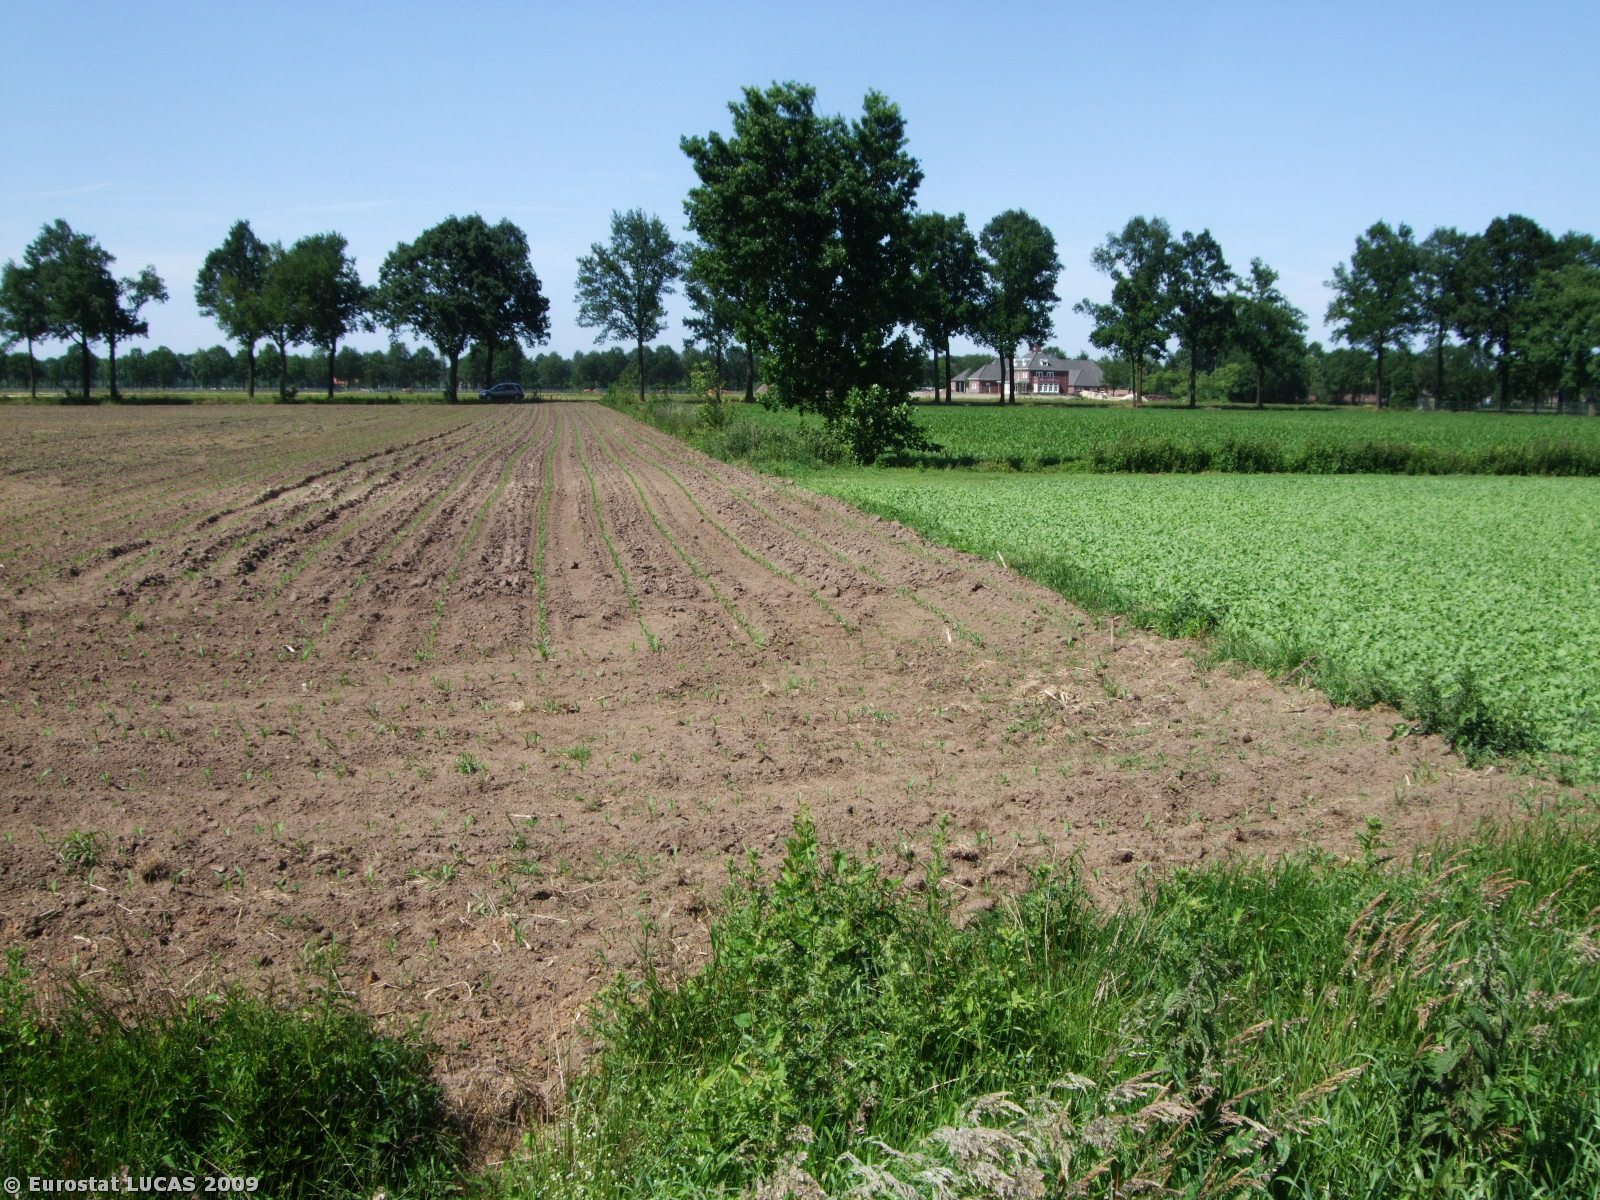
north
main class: Cropland
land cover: Other root crops
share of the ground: > 75 %
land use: Agriculture (excluding fallow land and kitchen gardens)
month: June
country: NL
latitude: 51.5882
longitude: 5.4516
